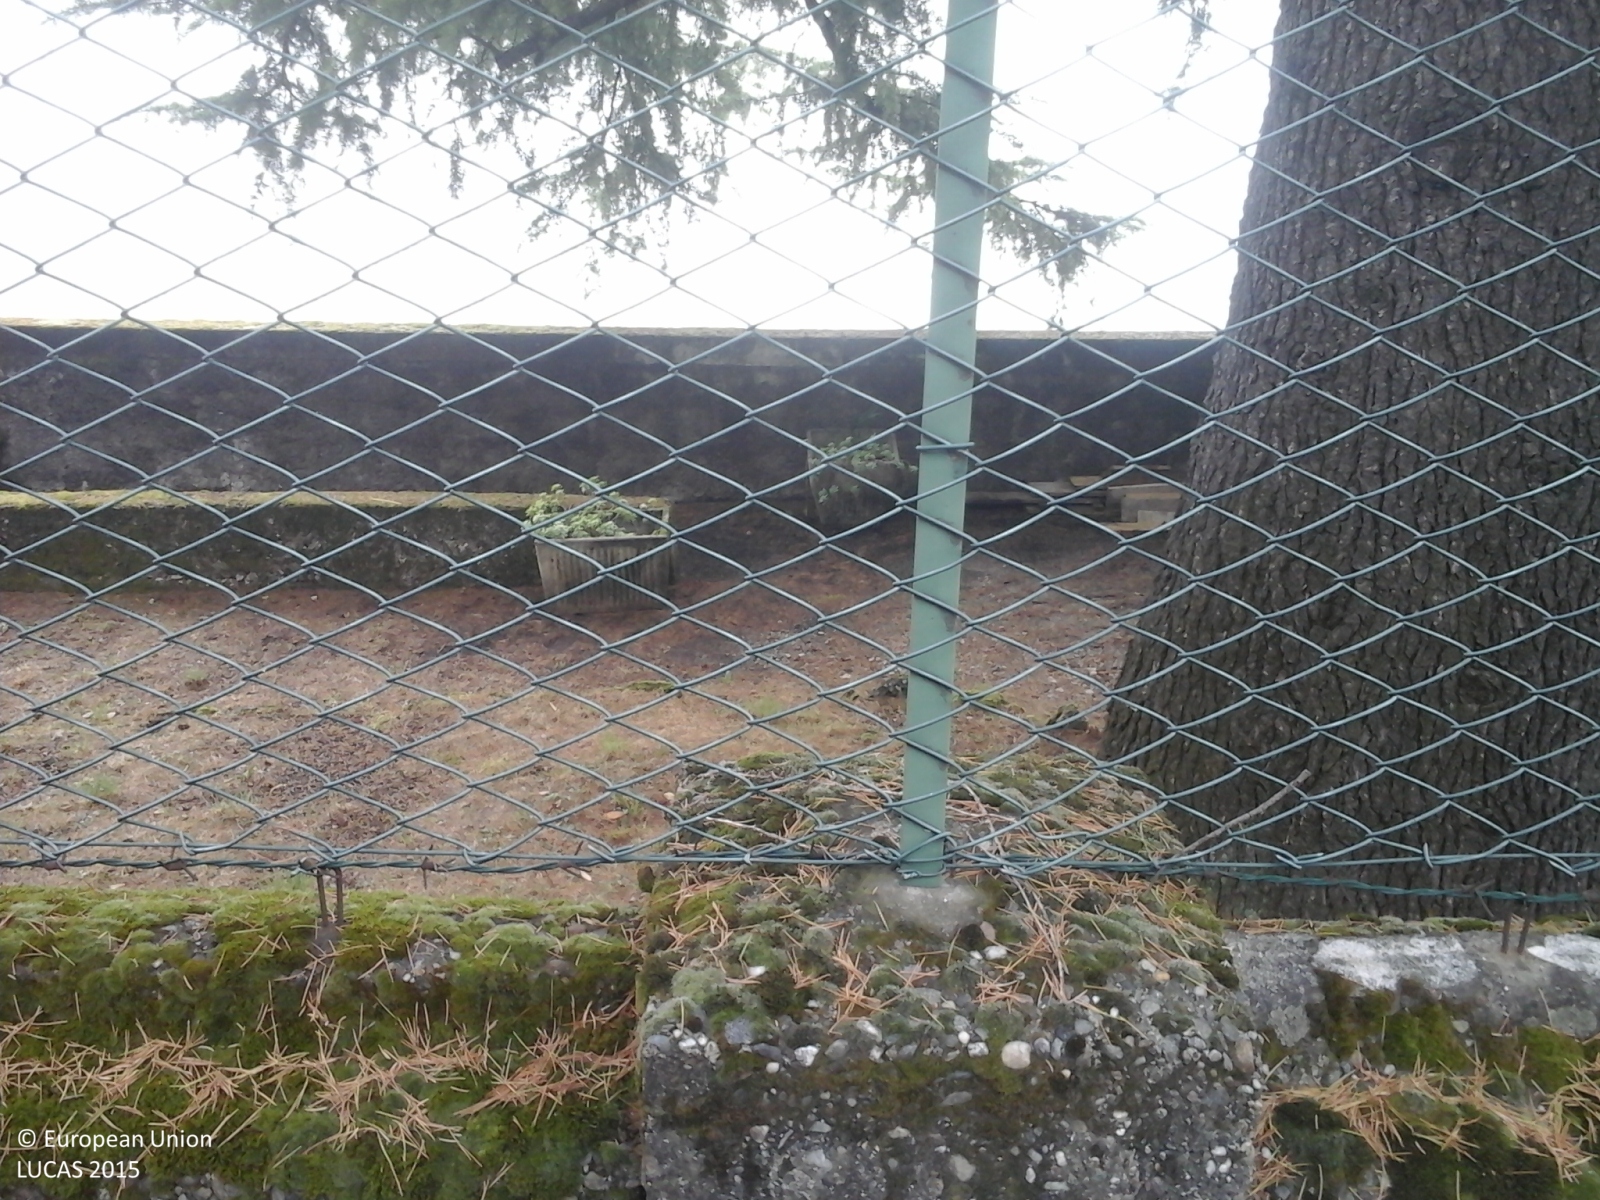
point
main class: Woodland
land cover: Other coniferous woodland
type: alpine coniferous forest
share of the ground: > 75 %
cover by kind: coniferous forest trees 100 %
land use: Residential
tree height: > 5 m
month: July
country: IT
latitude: 45.9165
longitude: 9.2920
